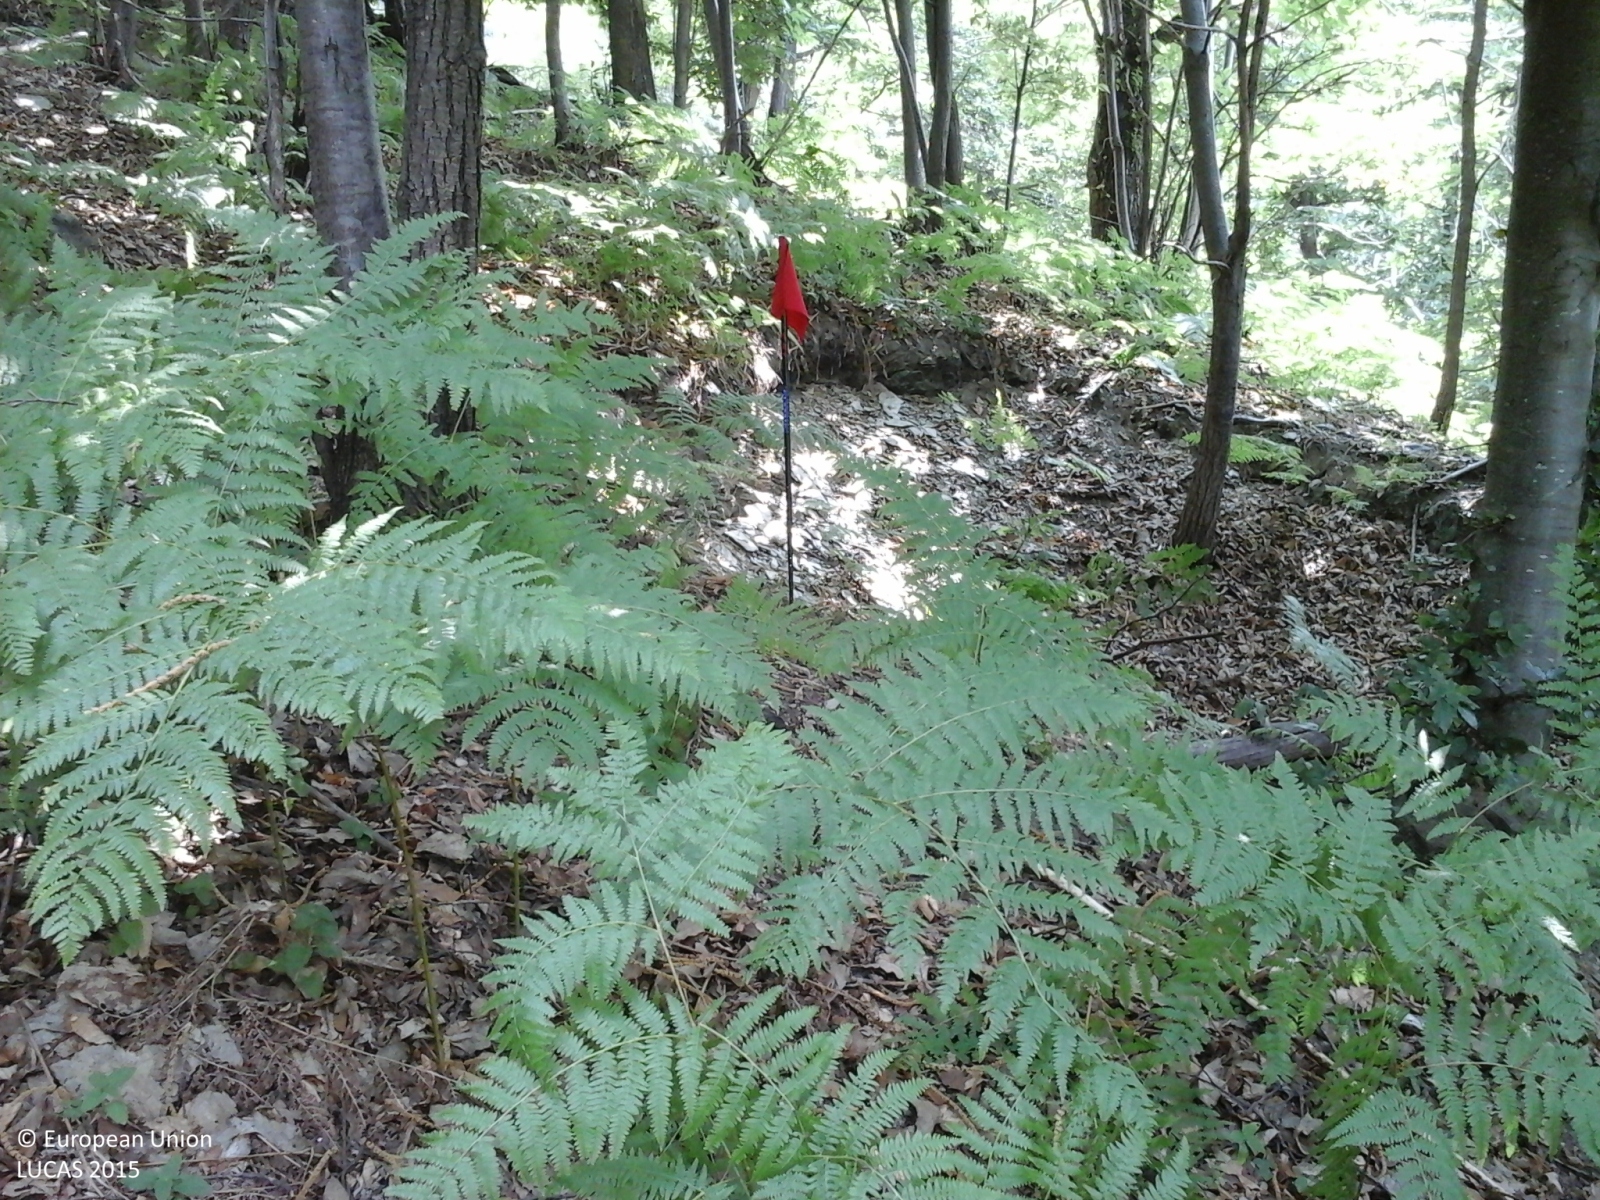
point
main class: Woodland
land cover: Broadleaved woodland
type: mountainous beech forest
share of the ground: > 75 %
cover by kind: broadleaved forest trees 90 %, shrubs 5 %, unconsolidated bare surface 5 %
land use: Forestry
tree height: > 5 m
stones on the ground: < 10 %
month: July
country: IT
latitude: 44.2492
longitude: 7.5383
